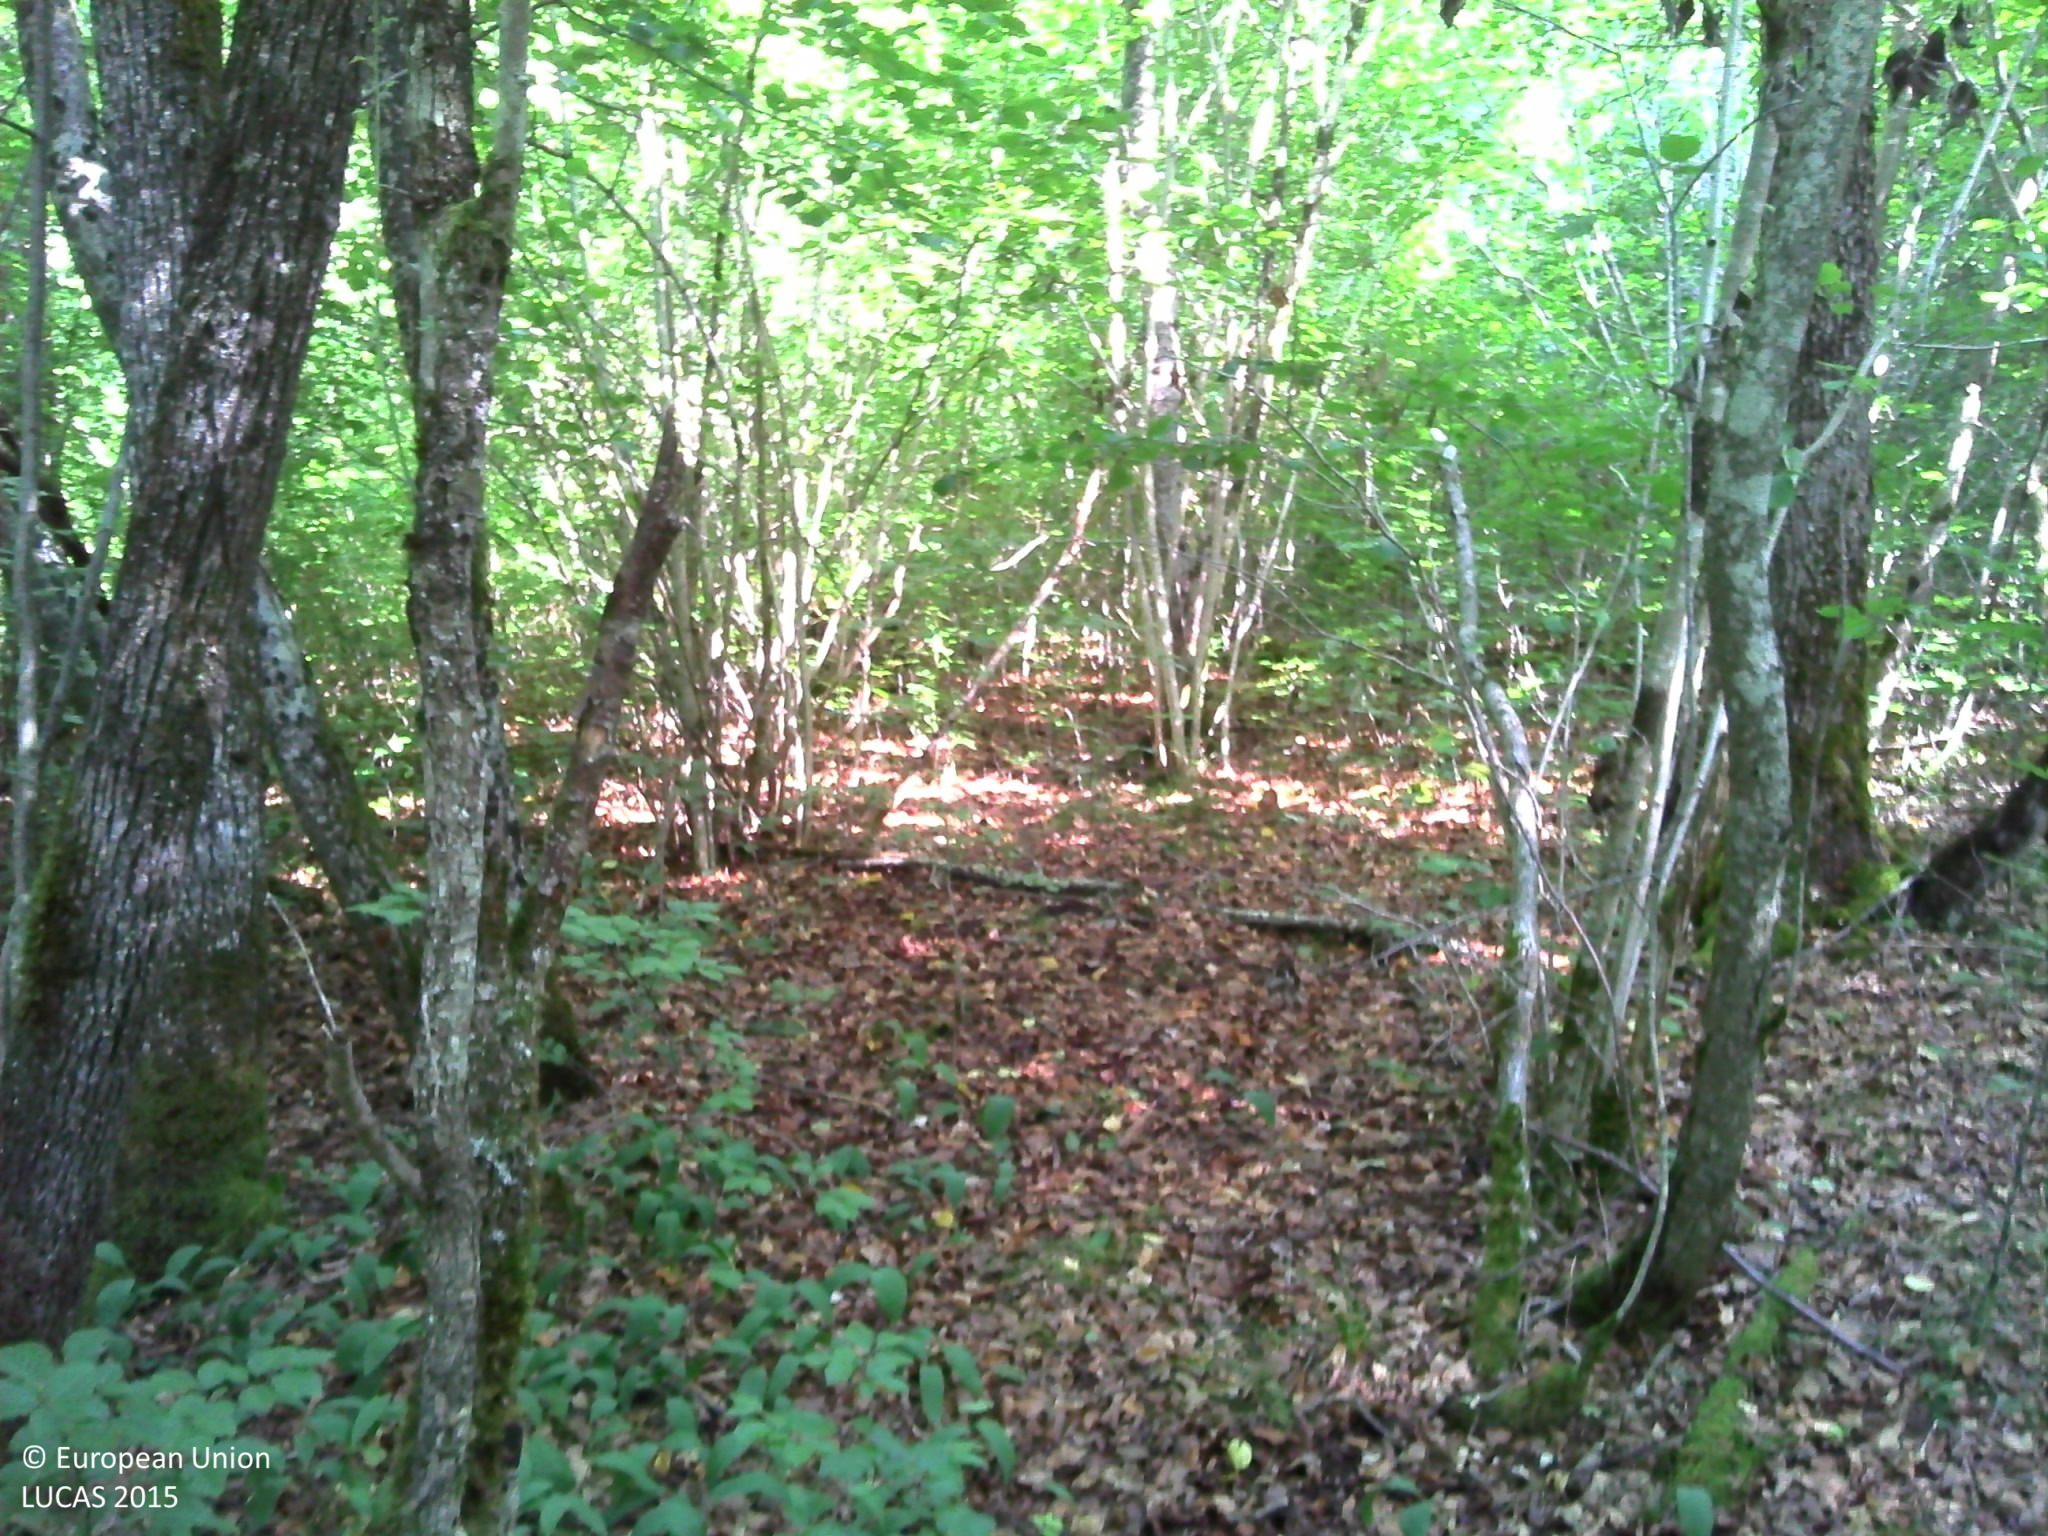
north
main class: Woodland
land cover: Broadleaved woodland
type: mesophytic deciduous forest
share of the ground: > 75 %
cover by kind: broadleaved forest trees 90 %, herbaceous plants 5 %, lichens and mosses 5 %
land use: Forestry
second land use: Amenities, museums, leisure
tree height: > 5 m
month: August
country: FR
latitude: 47.8100
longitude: 4.7510
